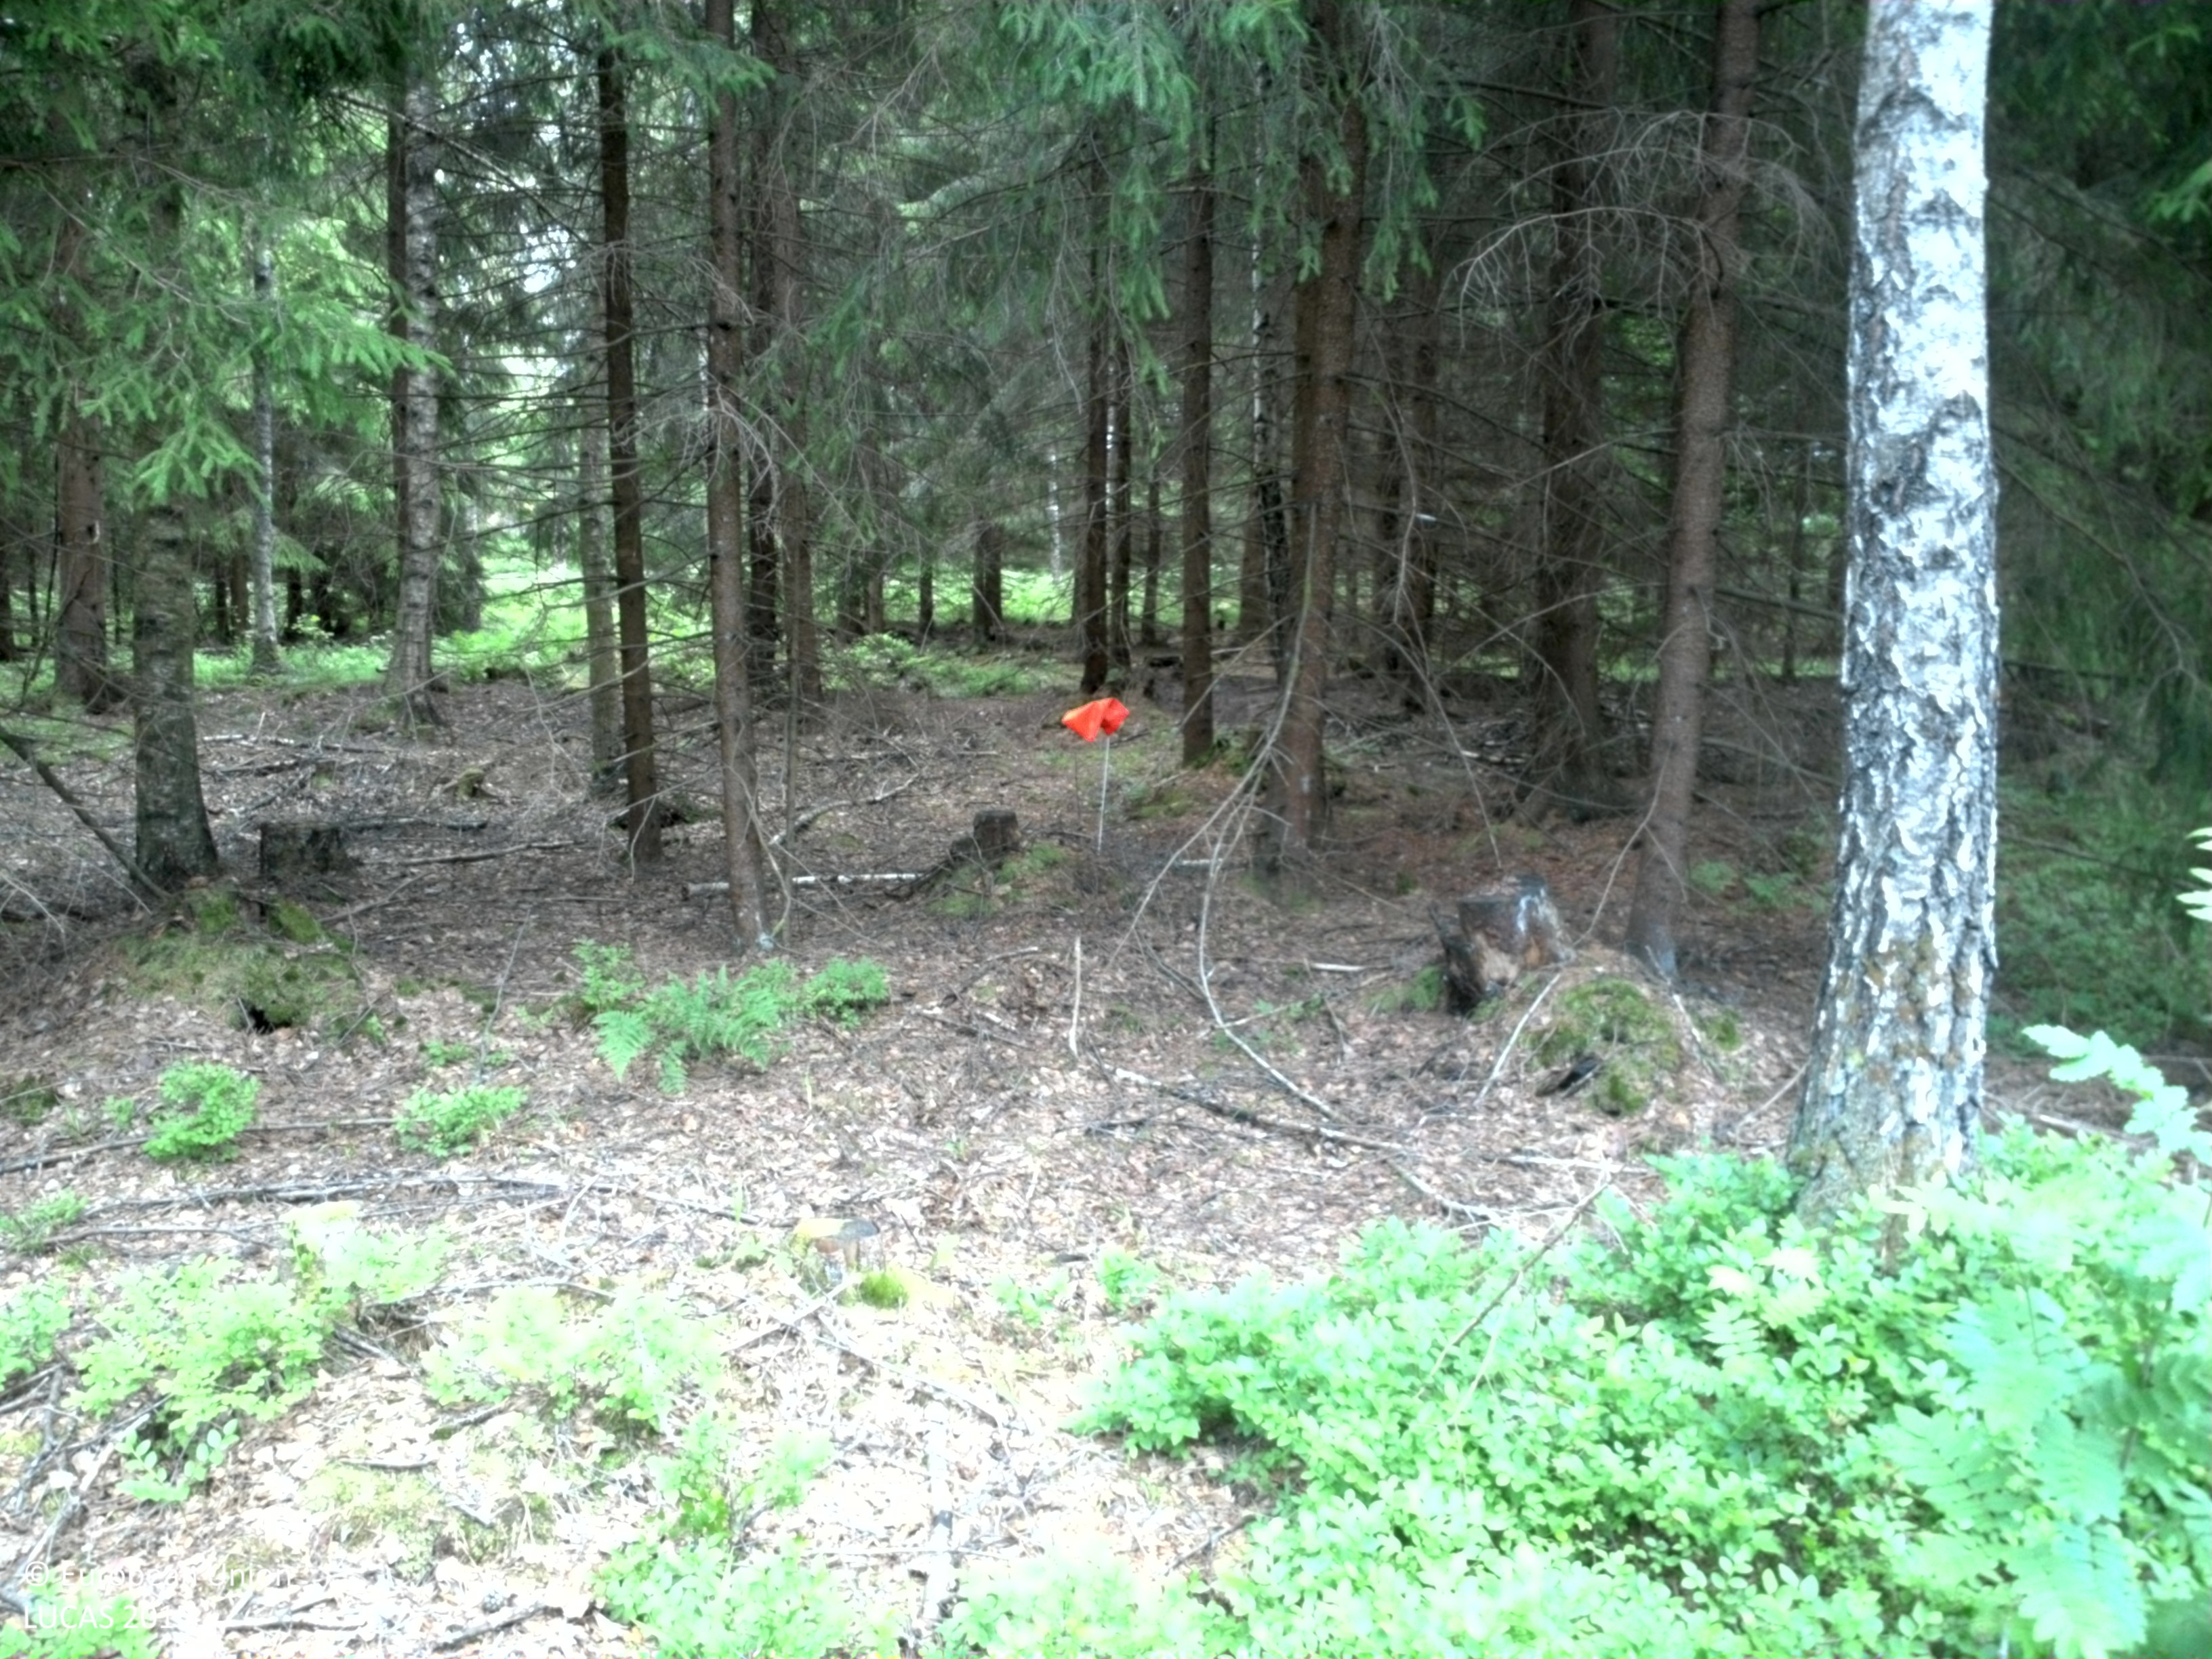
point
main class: Woodland
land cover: Spruce dominated coniferous woodland
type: boreal forest
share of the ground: 50 - 75 %
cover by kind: coniferous forest trees 70 %, herbaceous plants 10 %, consolidated bare surface 10 %, broadleaved forest trees 5 %, lichens and mosses 5 %
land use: Forestry
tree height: > 5 m
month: June
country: SE
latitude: 58.5629
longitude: 15.3743
